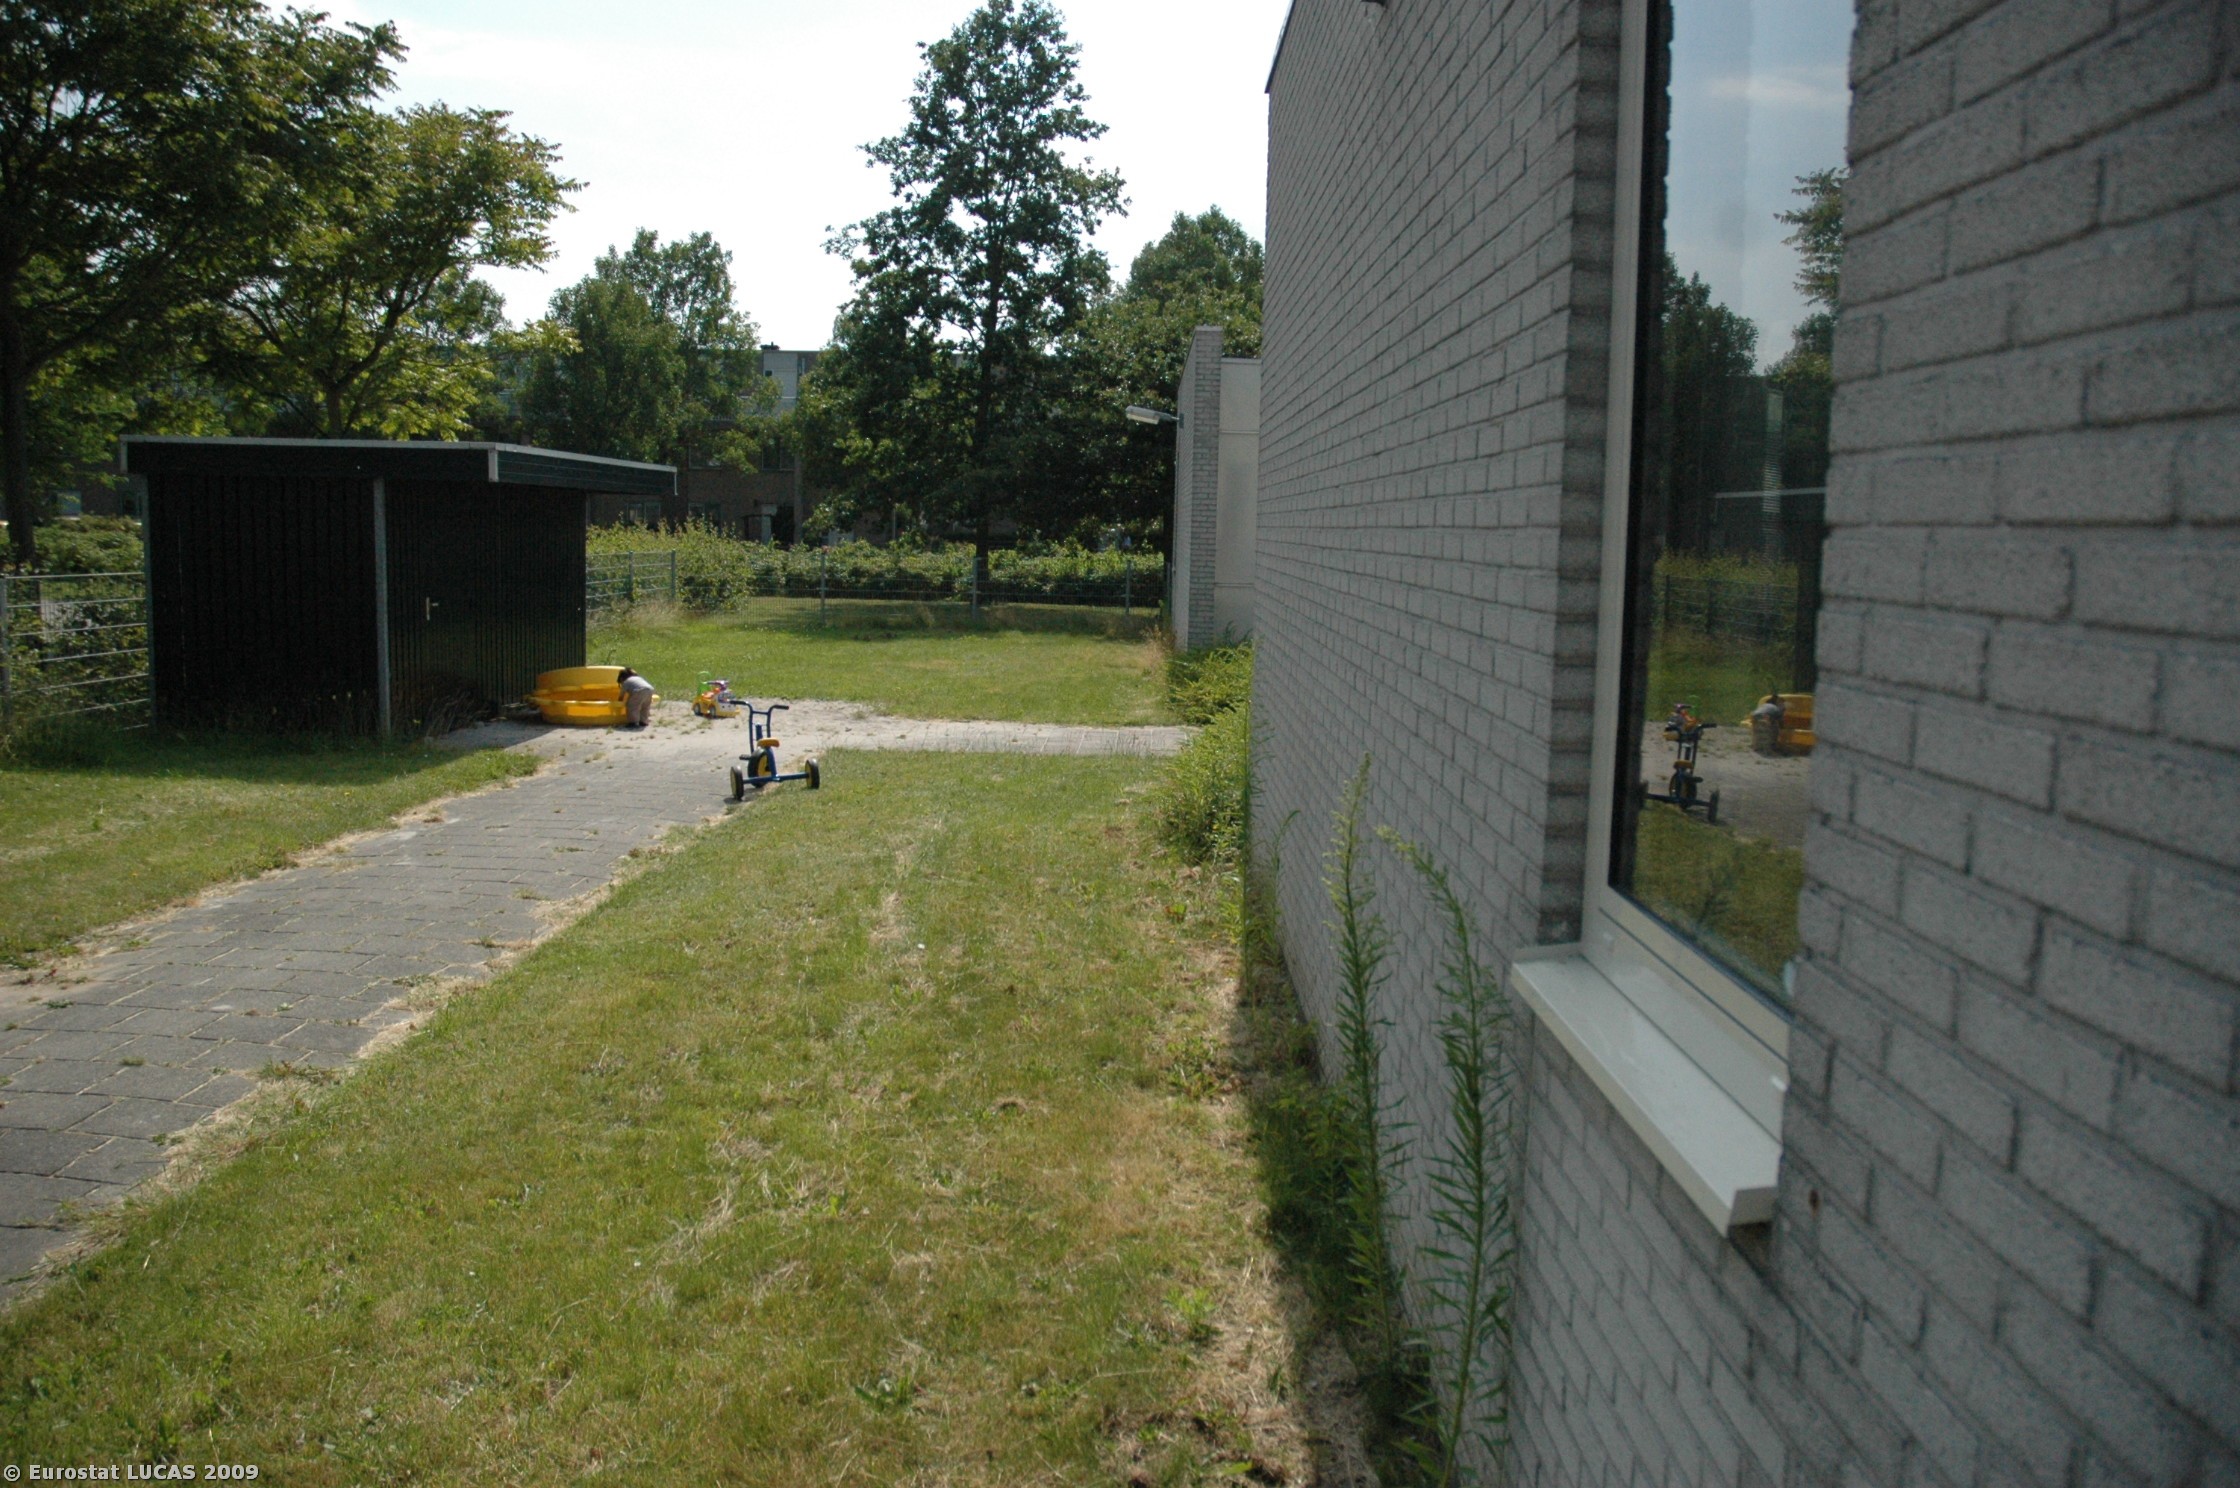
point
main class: Grassland
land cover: Grassland without tree/shrub cover
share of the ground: > 75 %
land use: Residential
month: June
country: NL
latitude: 52.3918
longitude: 5.2810
